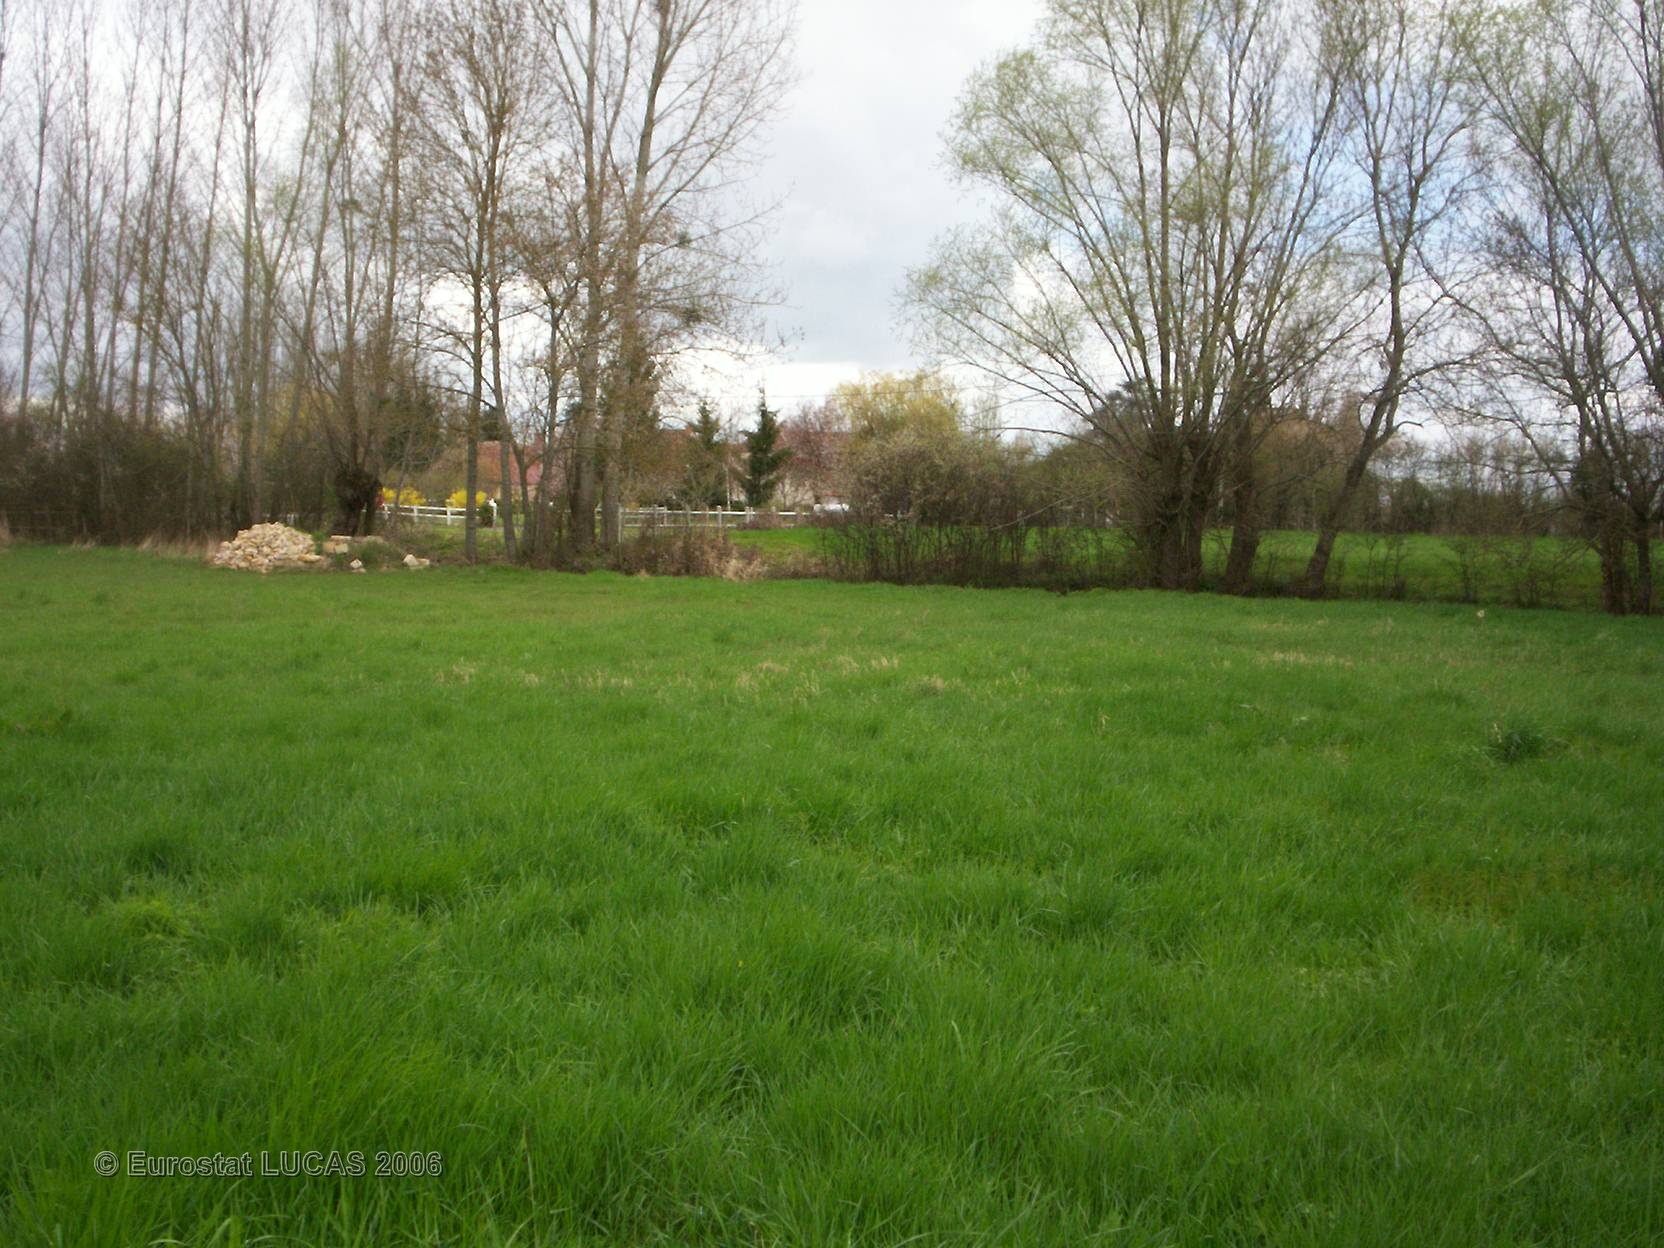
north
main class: Grassland
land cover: Grassland without tree/shrub cover
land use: Agriculture (excluding fallow land and kitchen gardens)
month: April
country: FR
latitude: 46.8502
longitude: 3.0850
